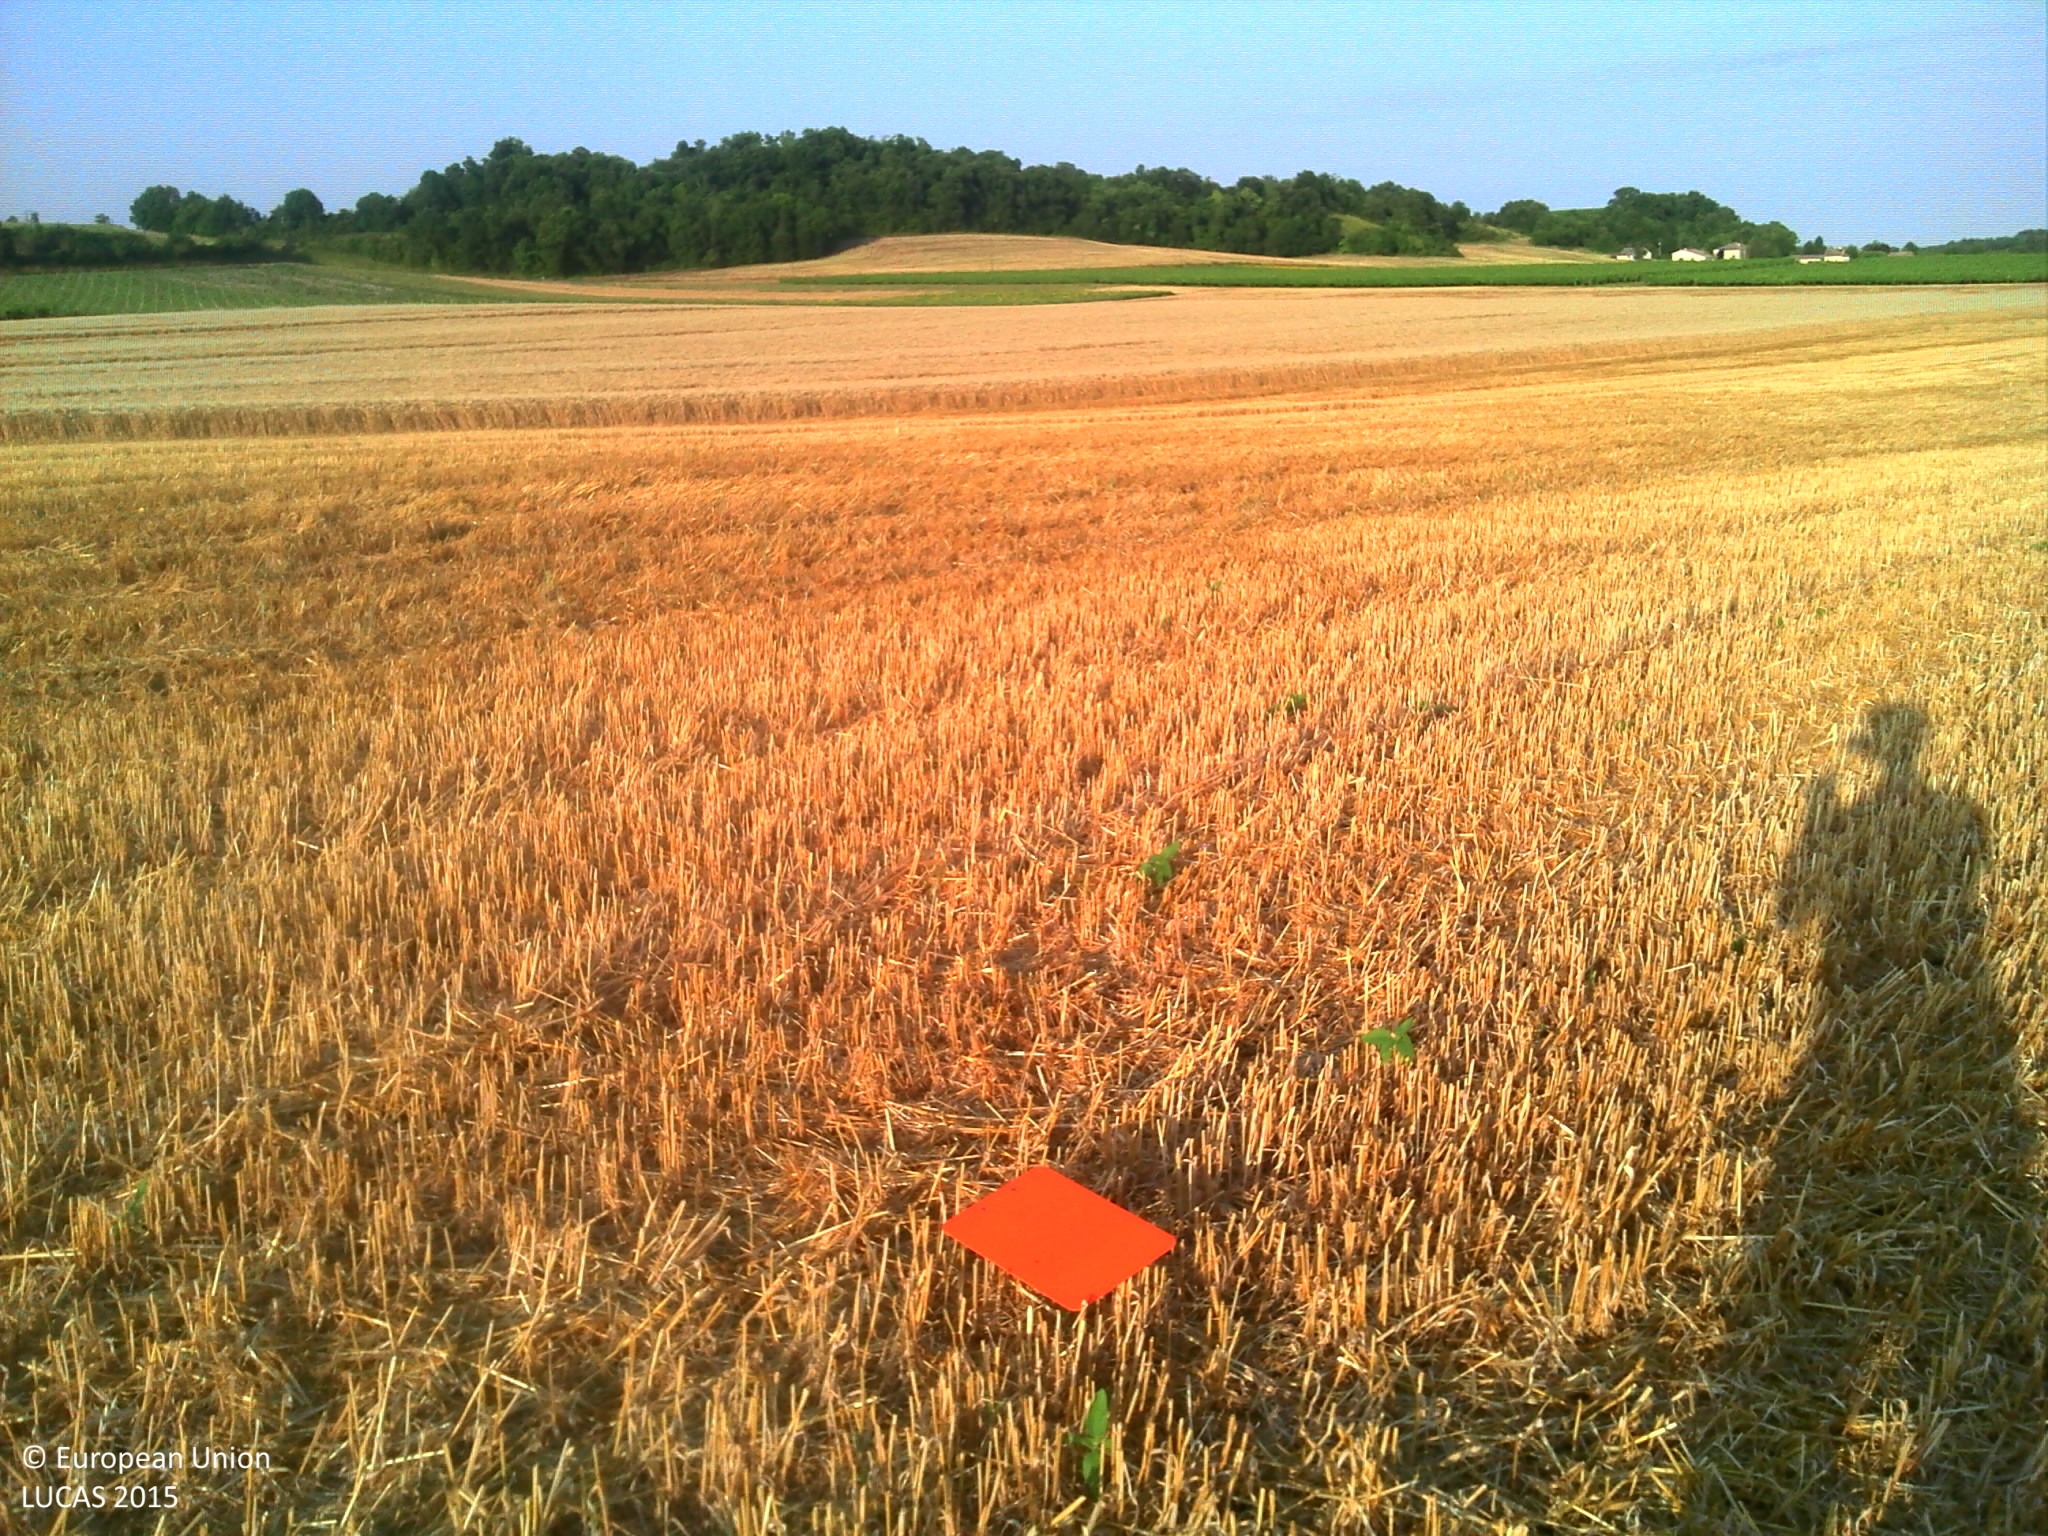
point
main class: Cropland
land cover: Durum wheat
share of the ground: > 75 %
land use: Agriculture (excluding fallow land and kitchen gardens)
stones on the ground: < 10 %
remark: Harvested field
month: July
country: FR
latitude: 45.3657
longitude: -0.6317
